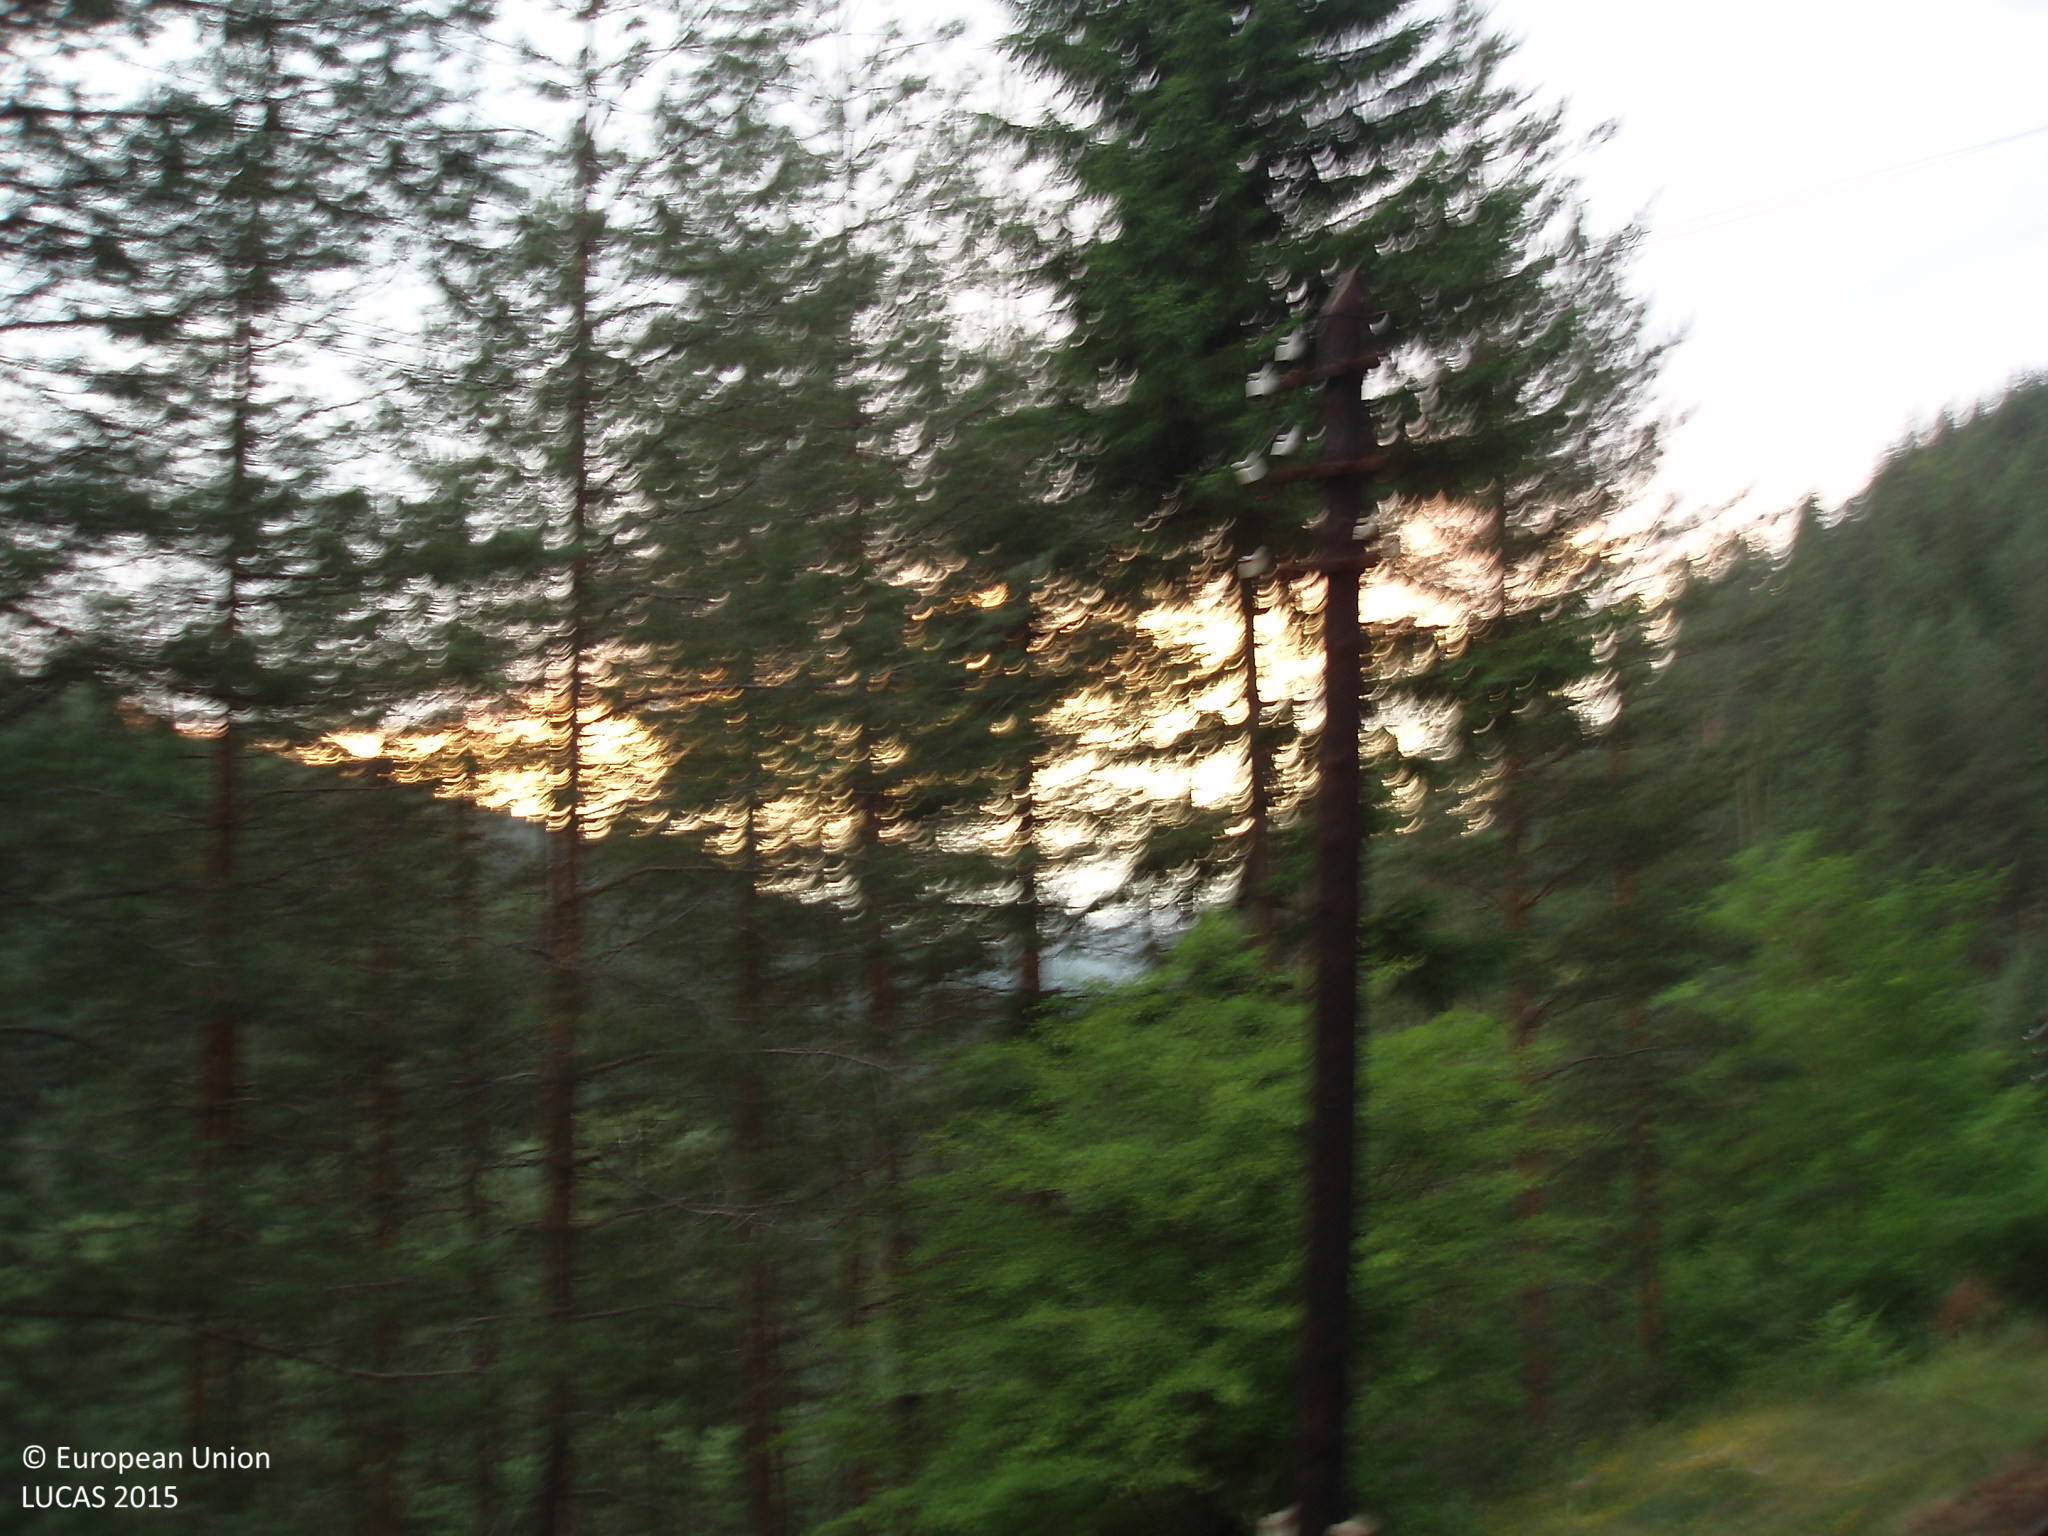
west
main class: Woodland
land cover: Other mixed woodland
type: hemiboreal forest and nemoral coniferous forest and mixed broadleaved-coniferous forest
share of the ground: 50 - 75 %
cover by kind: coniferous forest trees 65 %, broadleaved forest trees 25 %, herbaceous plants 10 %
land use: Forestry
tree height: > 5 m
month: July
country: BG
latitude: 42.0412
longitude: 23.7452
